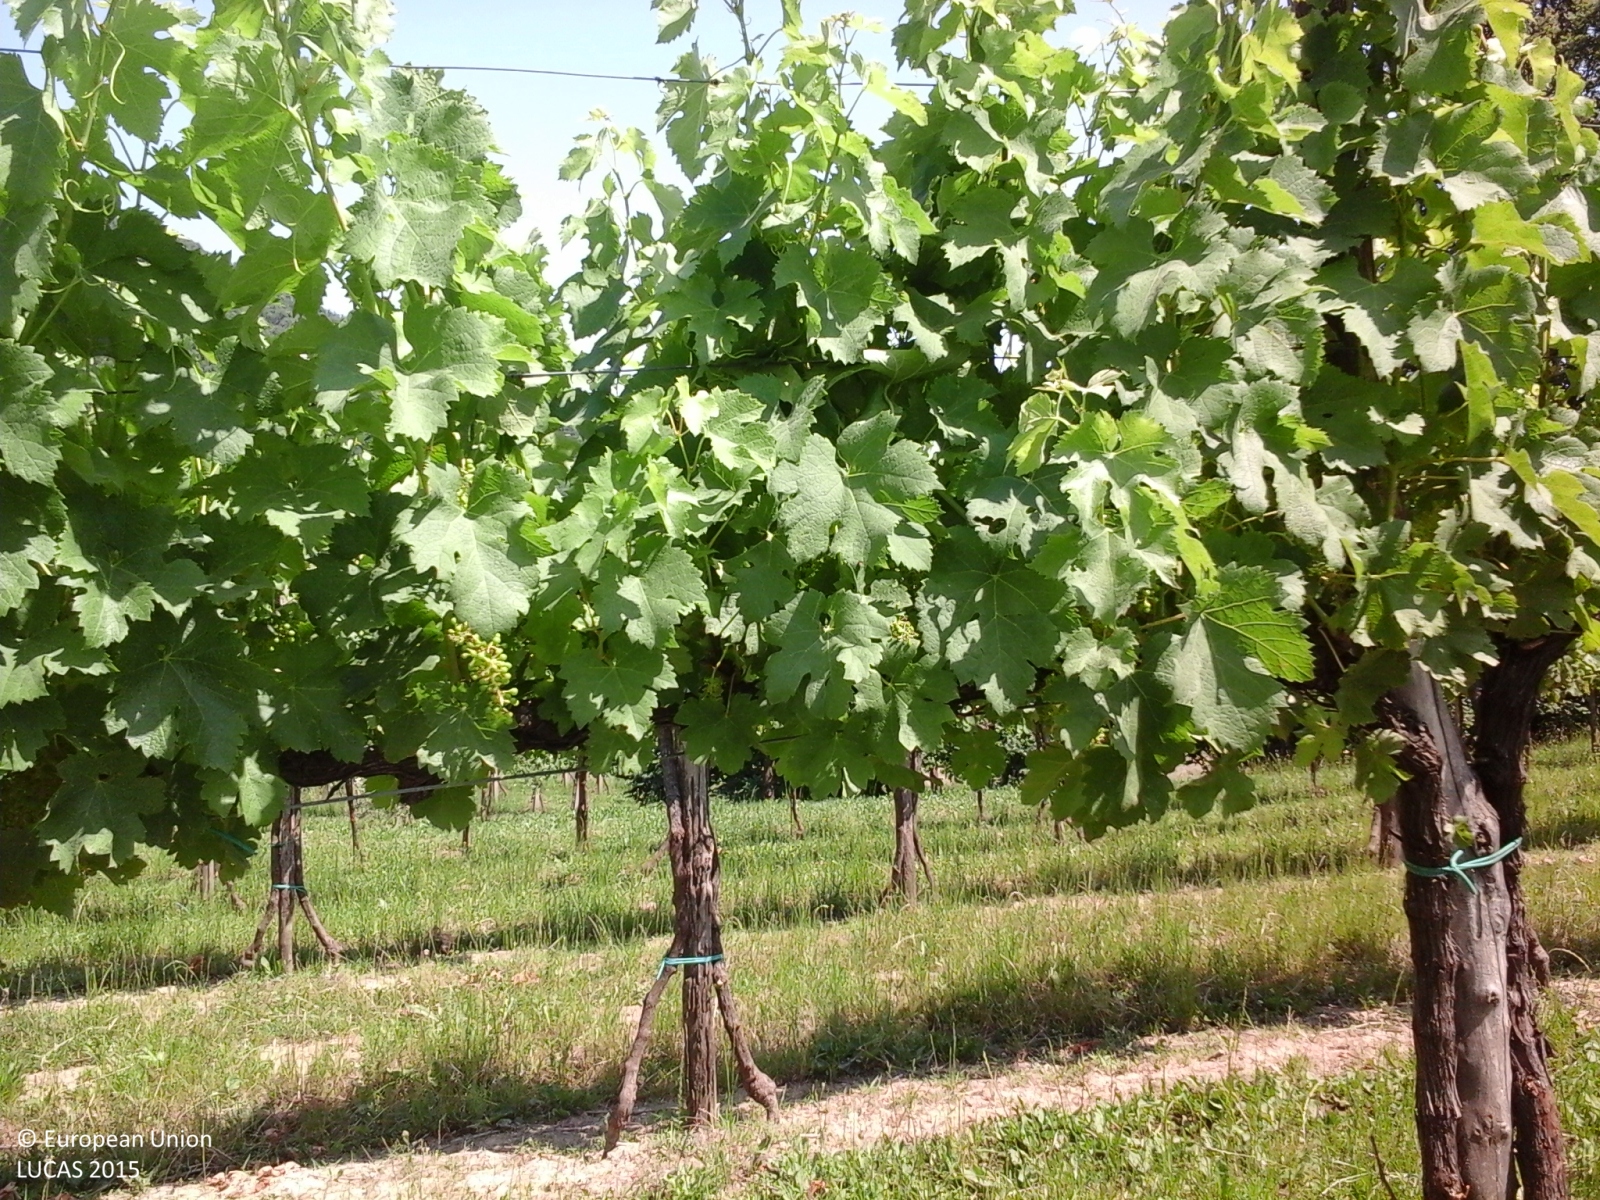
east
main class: Cropland
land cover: Vineyards
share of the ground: 50 - 75 %
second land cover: Grassland without tree/shrub cover
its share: > 75 %
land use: Agriculture (excluding fallow land and kitchen gardens)
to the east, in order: Vineyards; Grassland without tree/shrub cover; Olive groves; Vineyards; Grass margins; Ditches and canals; Vineyards; Grassland without tree/shrub cover; Ditches and canals; Grassland without tree/shrub cover; Managed hedges; Ditches and canals; Managed hedges; Common wheat; Ditches and canals; Grassland without tree/shrub cover; Vineyards
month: June
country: IT
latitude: 45.3462
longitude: 11.7201
